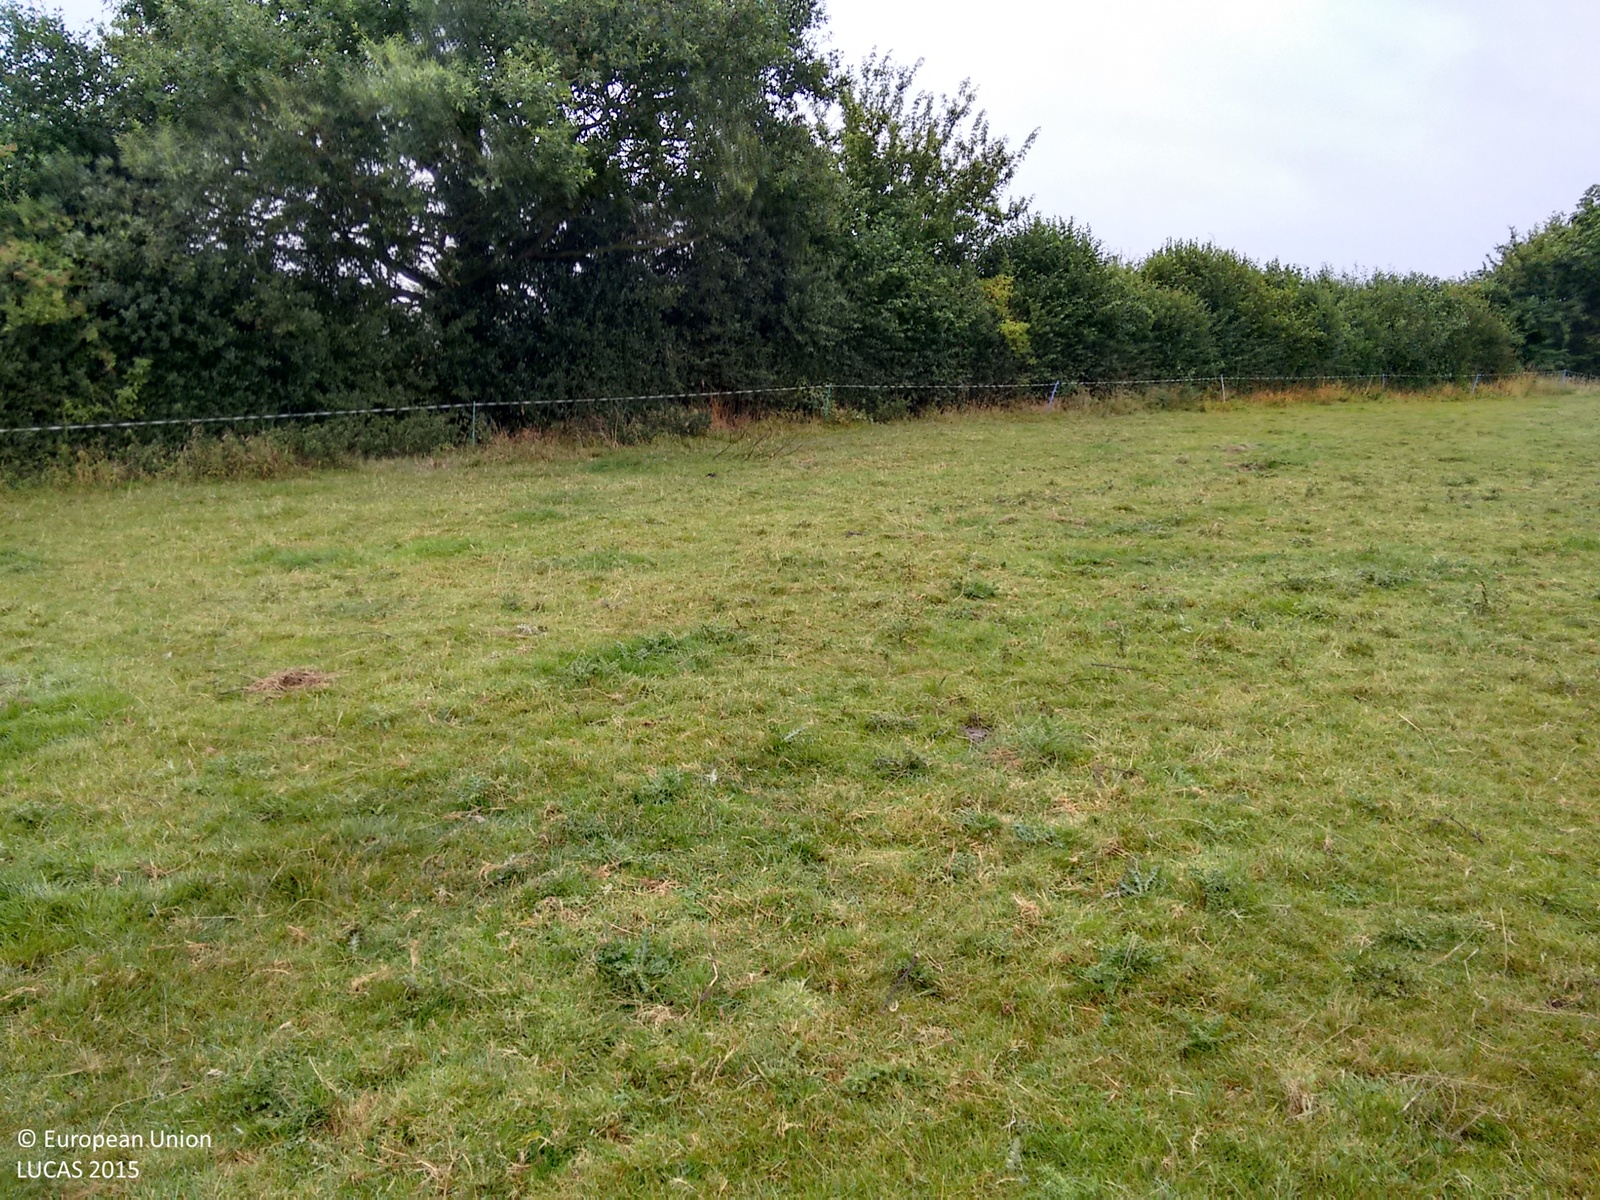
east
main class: Grassland
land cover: Grassland without tree/shrub cover
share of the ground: > 75 %
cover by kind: herbaceous plants 100 %
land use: Agriculture (excluding fallow land and kitchen gardens)
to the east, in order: Grassland without tree/shrub cover; Fences; Abandoned hedges; Fences; Grassland without tree/shrub cover; Electric lines; Grassland without tree/shrub cover; Broadleaved woodland; Grassland without tree/shrub cover; Abandoned hedges; Grass margins; Paved roads, cycling and walking lanes; Grass margins; Managed hedges; Grass margins; Common wheat
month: August
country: GB
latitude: 52.6273
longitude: -1.3805
